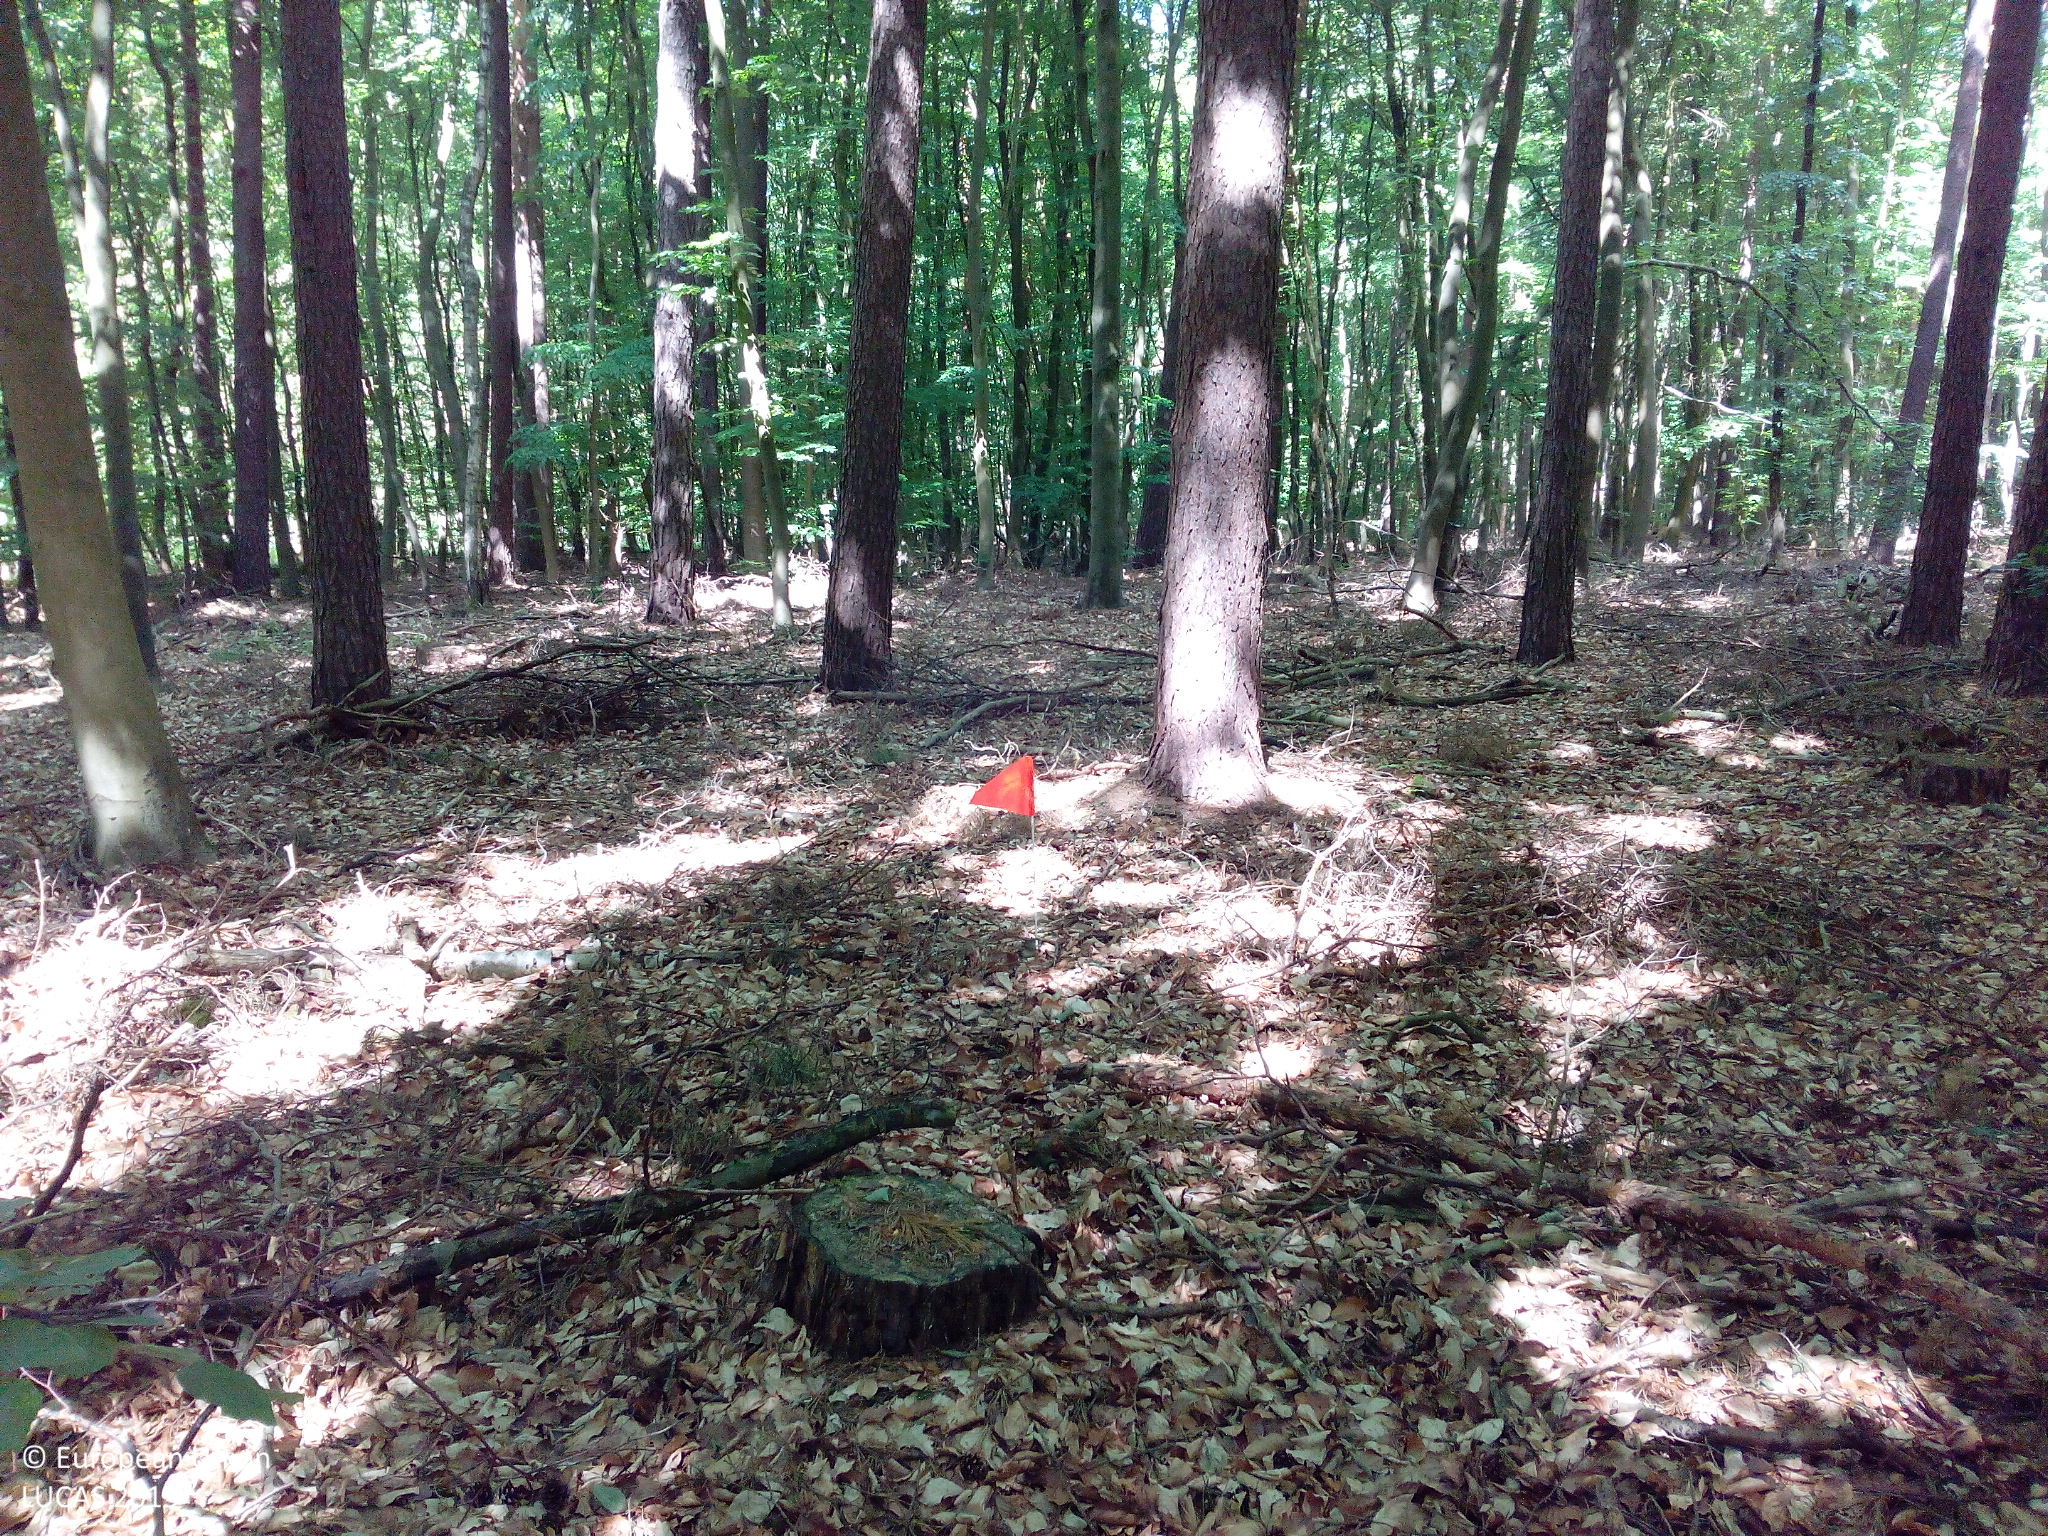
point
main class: Woodland
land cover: Pine dominated mixed woodland
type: hemiboreal forest and nemoral coniferous forest and mixed broadleaved-coniferous forest
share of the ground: > 75 %
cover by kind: coniferous forest trees 50 %, broadleaved forest trees 40 %, unconsolidated bare surface 10 %
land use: Forestry
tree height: > 5 m
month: June
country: DE
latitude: 53.5526
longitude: 11.6446
